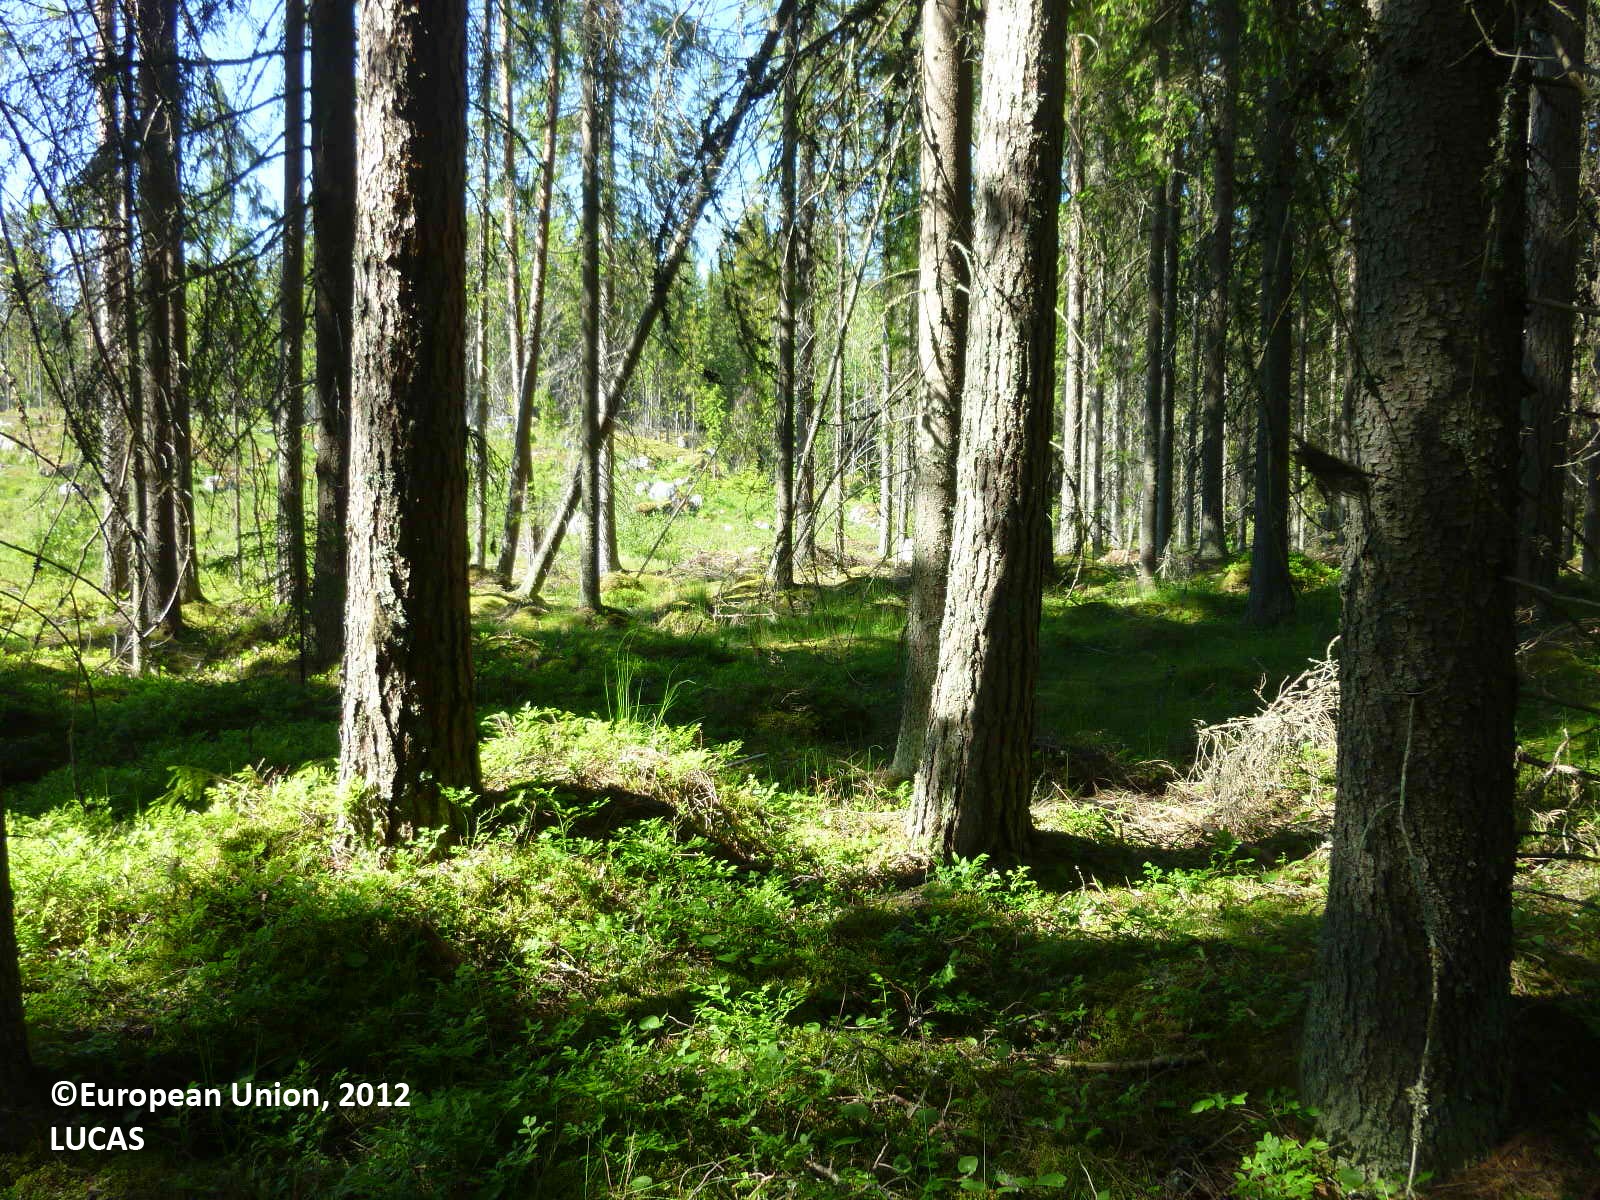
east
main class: Woodland
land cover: Spruce dominated coniferous woodland
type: boreal forest
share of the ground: > 75 %
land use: Forestry
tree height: > 5 m
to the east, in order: Spruce dominated coniferous woodland; Ditches and canals; Grass margins; Paved roads, cycling and walking lanes; Grass margins; Ditches and canals; Spruce dominated coniferous woodland; Rivers and streams; Spruce dominated coniferous woodland; Broadleaved woodland; Ditches and canals; Grass margins; Grassland without tree/shrub cover; Mixed cereals for fodder; Spruce dominated mixed woodland; Ditches and canals; Spruce dominated coniferous woodland
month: June
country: FI
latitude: 61.4940
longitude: 22.8220
